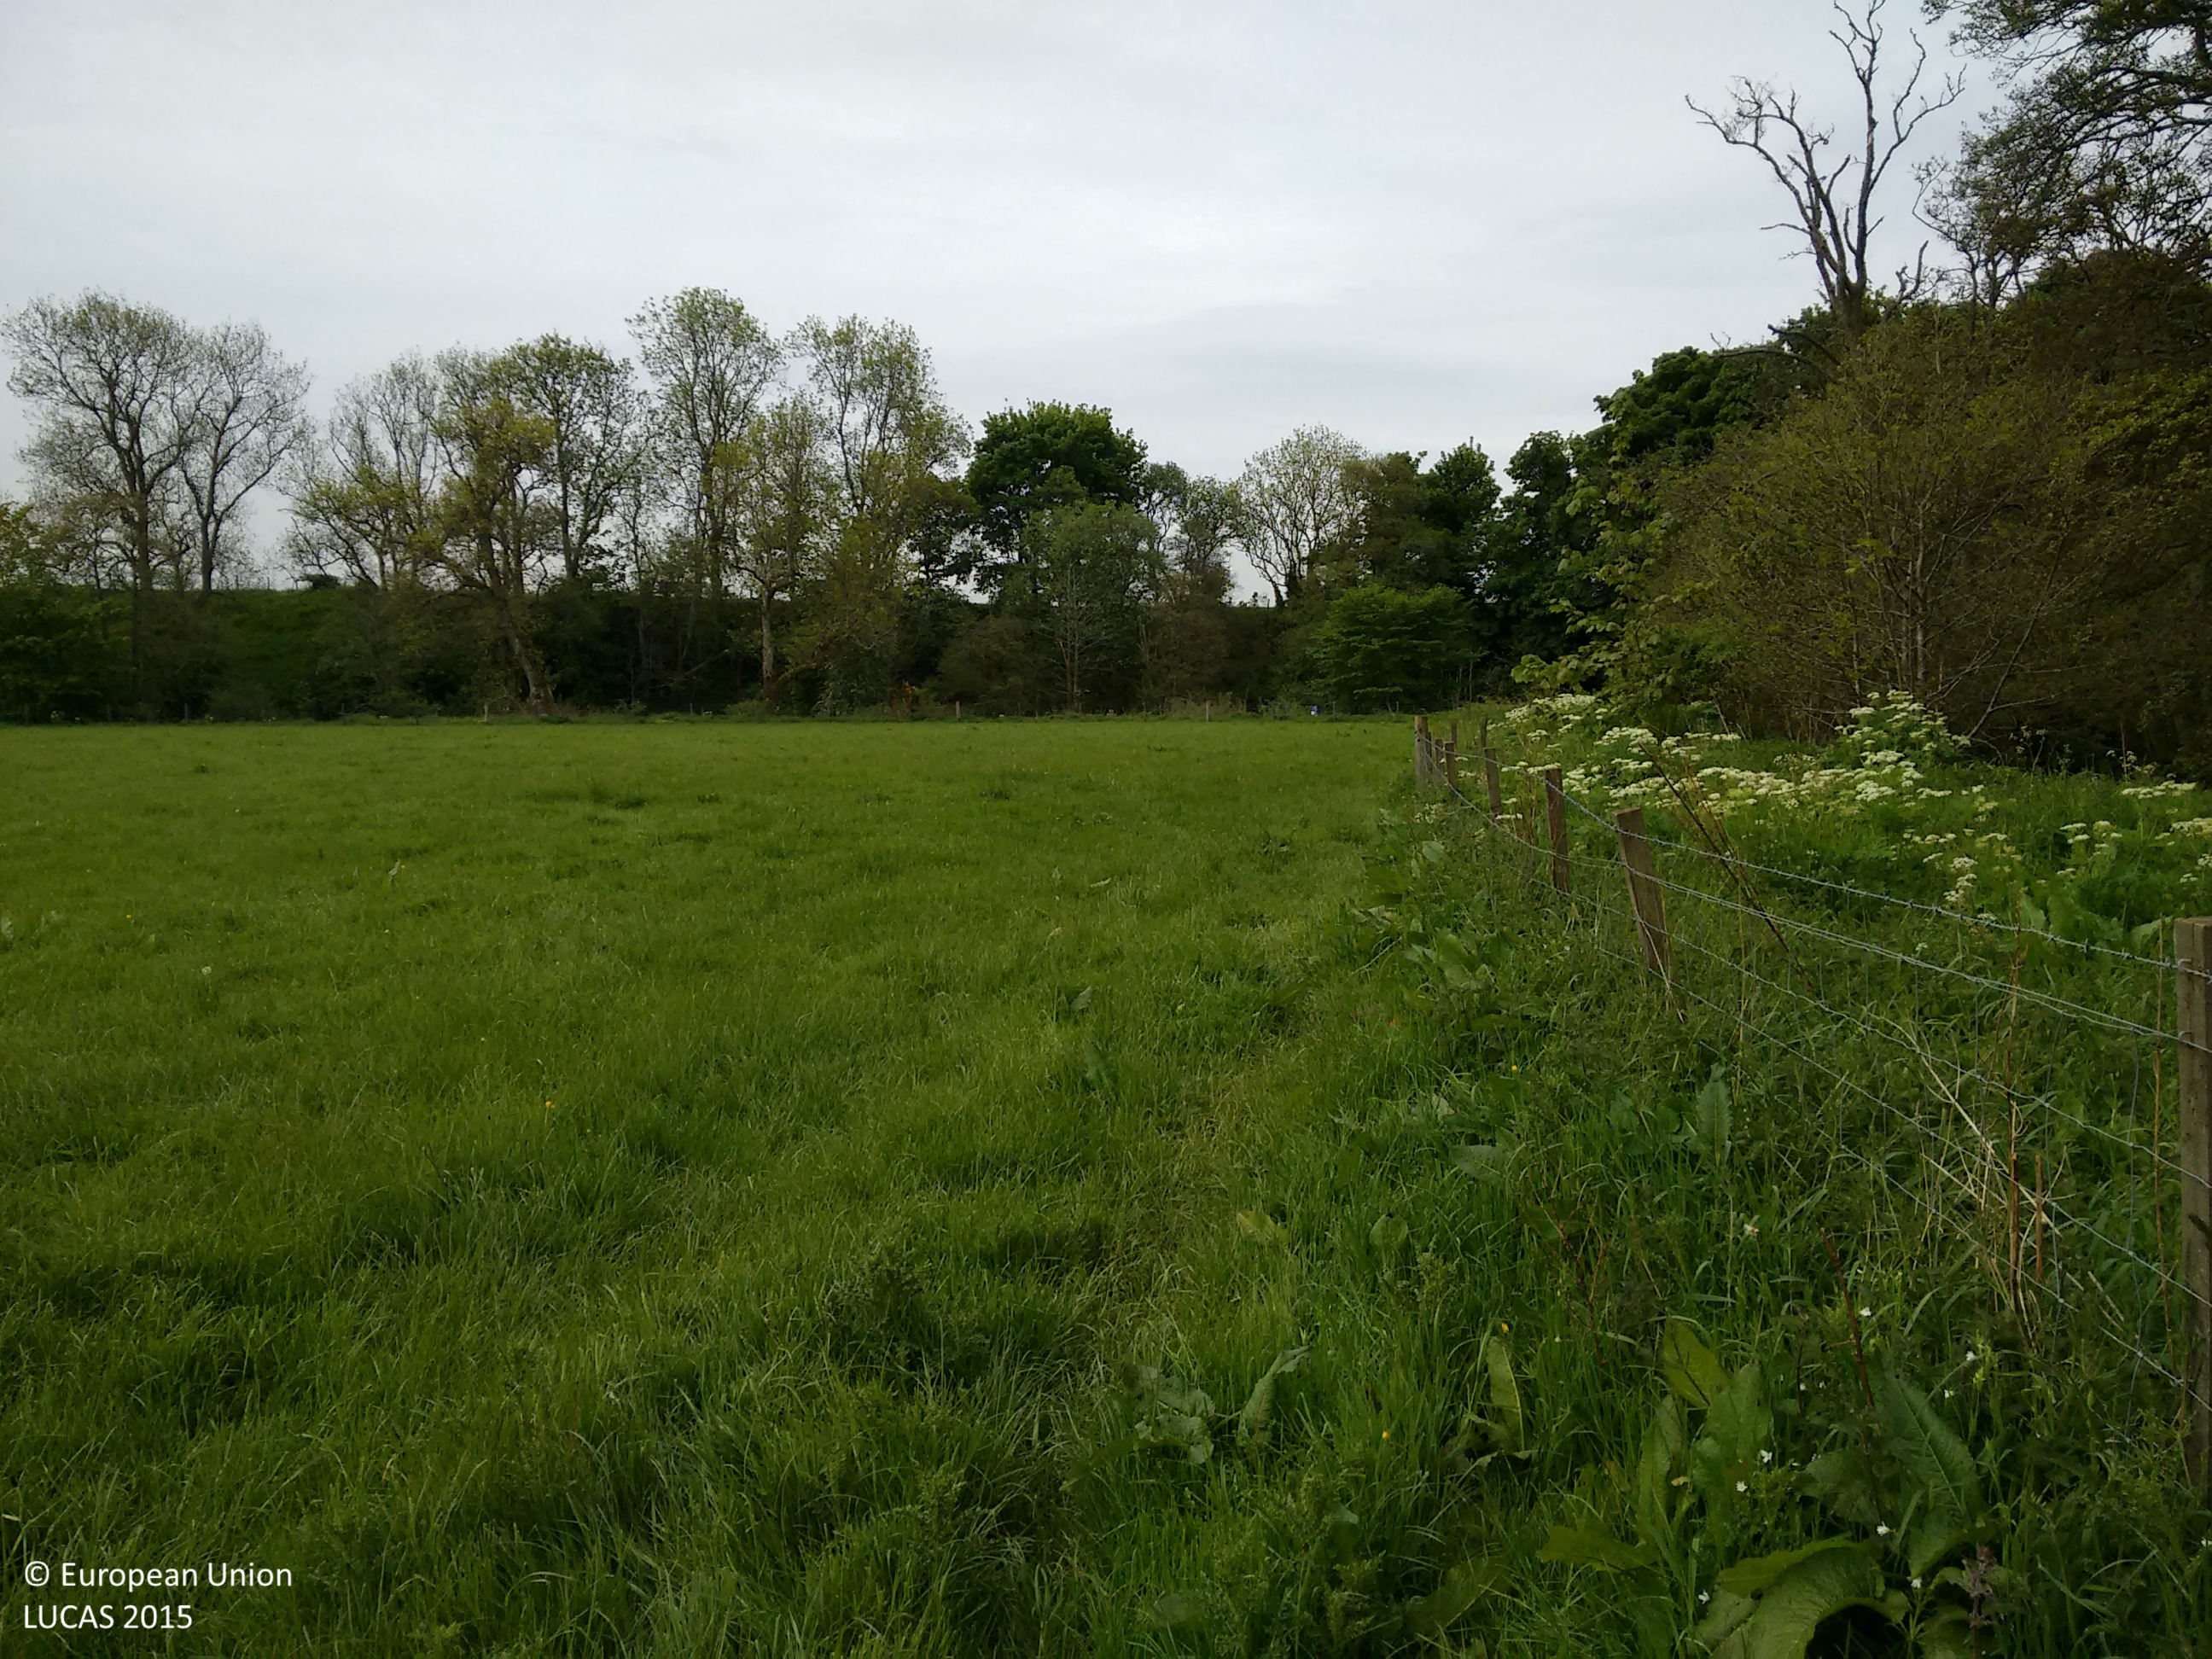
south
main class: Grassland
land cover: Grassland without tree/shrub cover
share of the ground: > 75 %
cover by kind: herbaceous plants 100 %
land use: Agriculture (excluding fallow land and kitchen gardens)
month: June
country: GB
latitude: 56.4533
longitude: -3.5266
